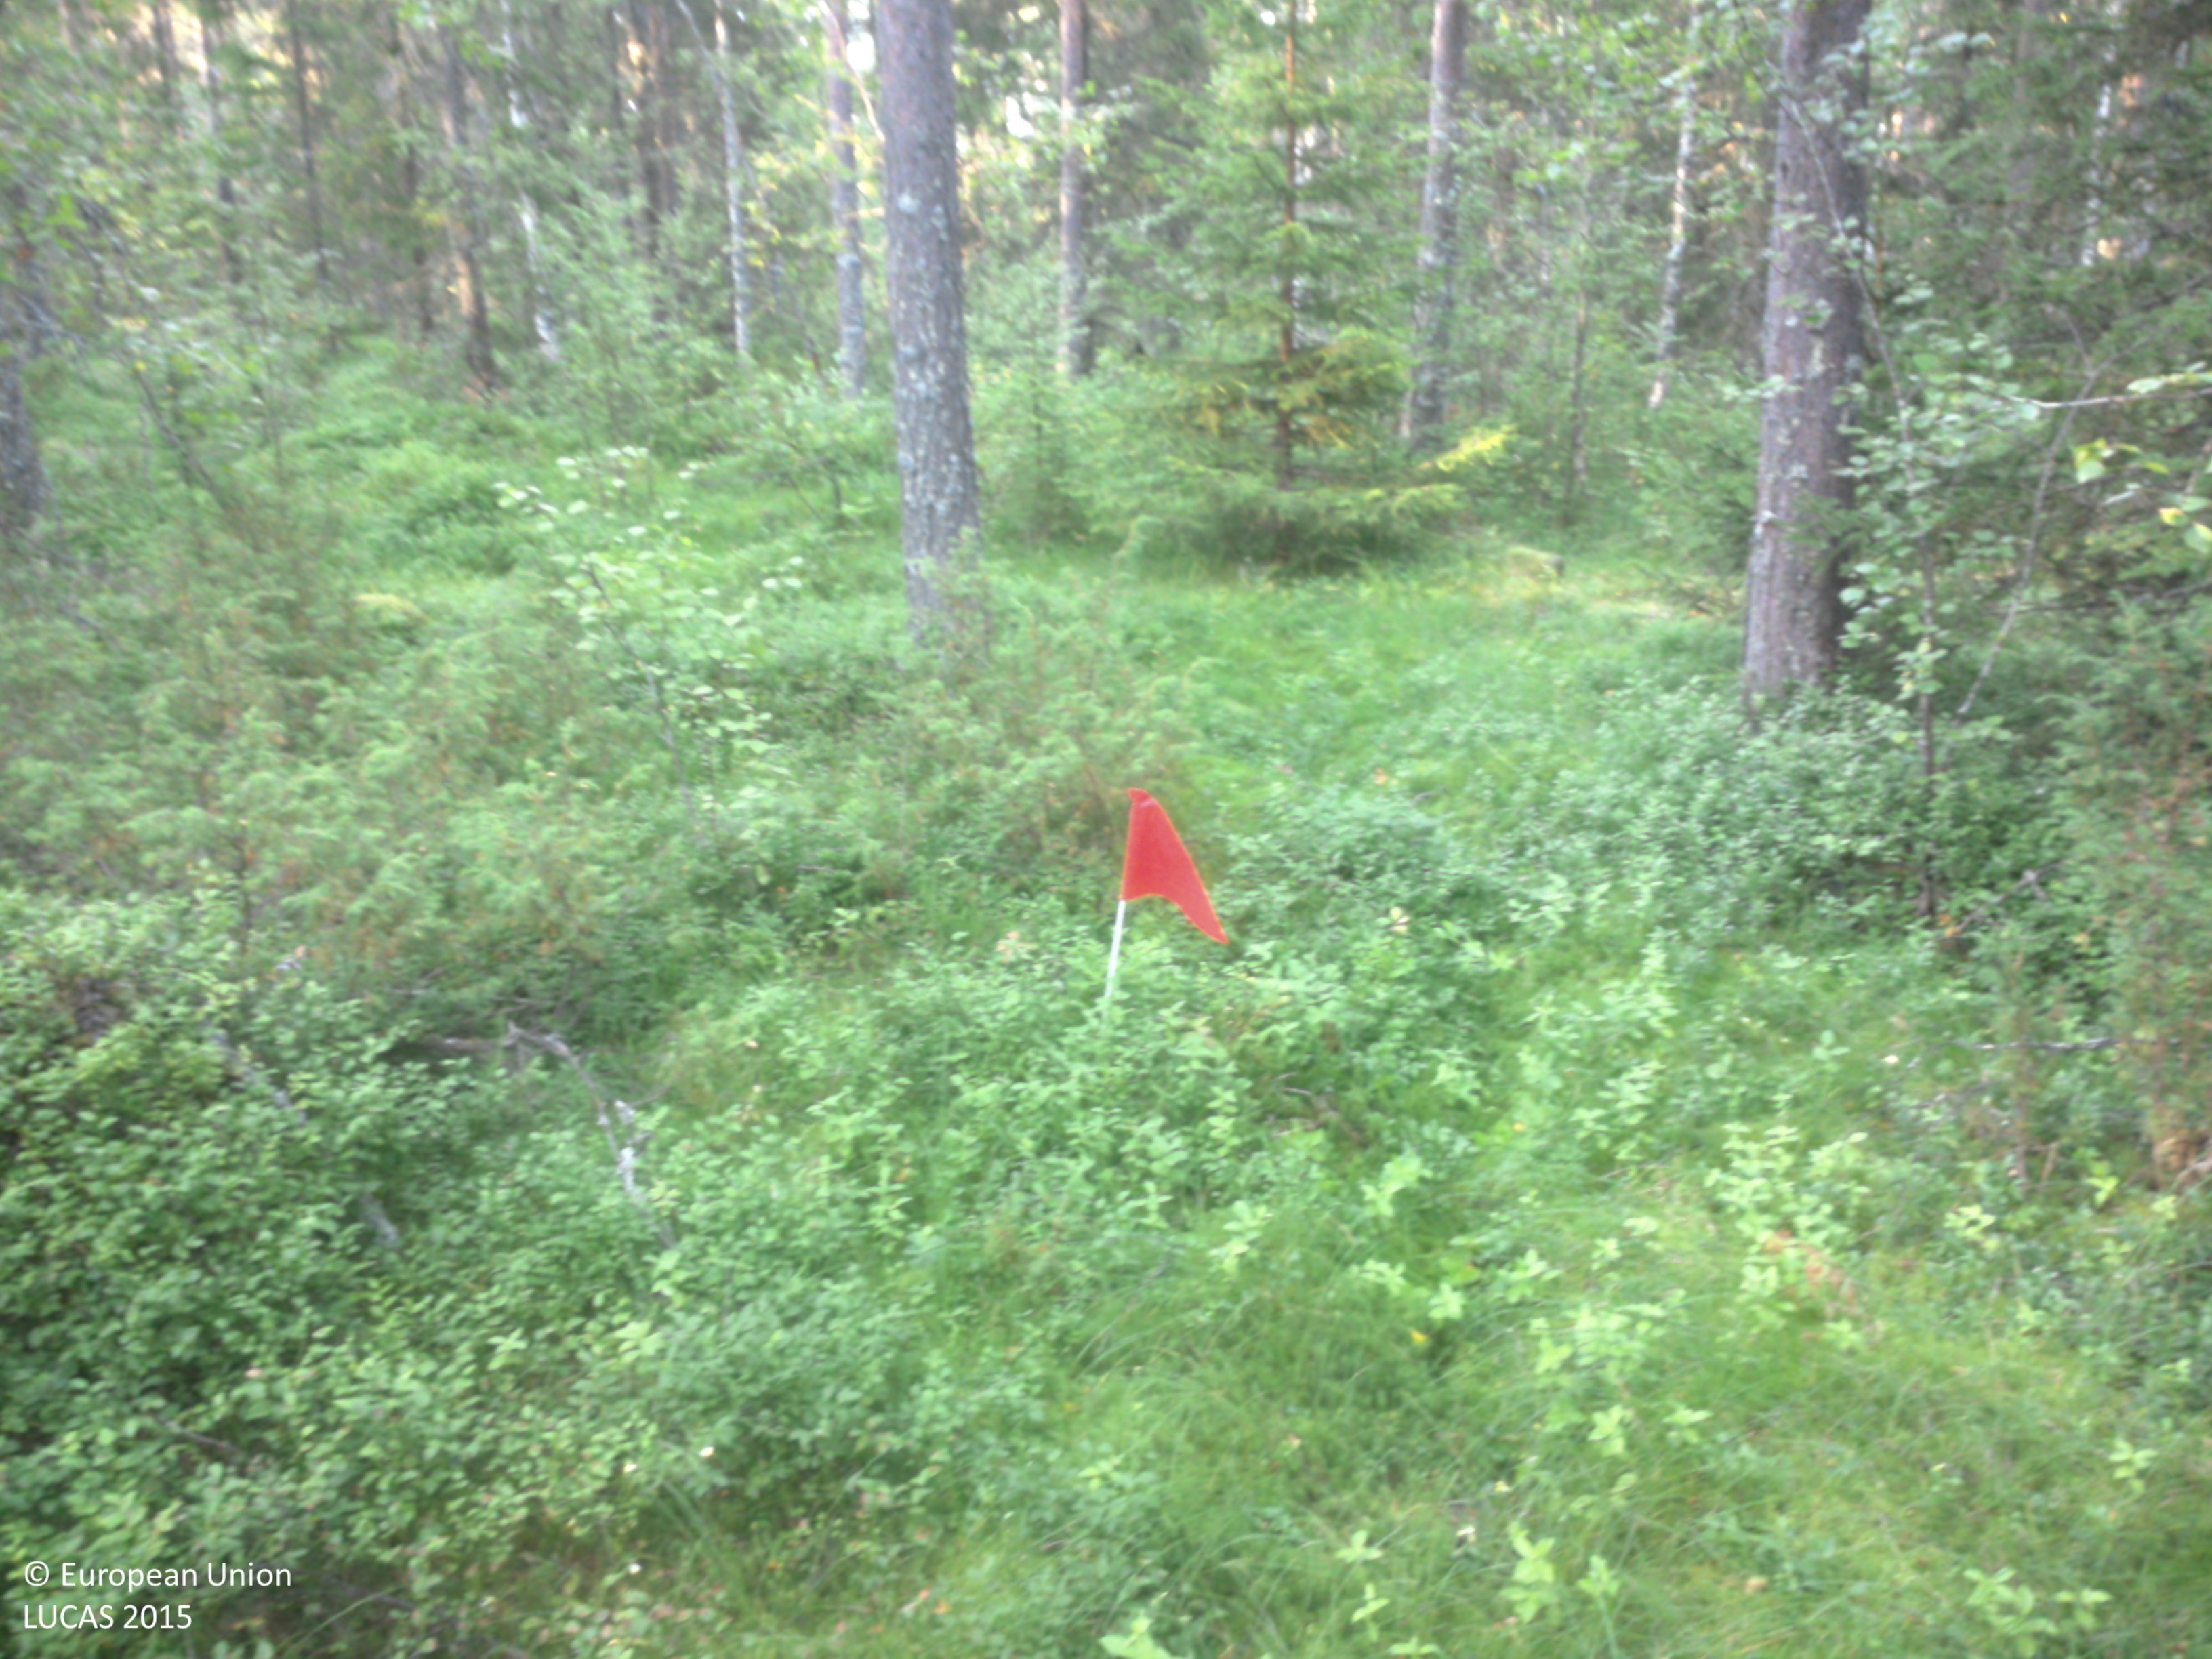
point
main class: Woodland
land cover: Other mixed woodland
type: boreal forest
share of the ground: 50 - 75 %
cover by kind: coniferous forest trees 40 %, herbaceous plants 30 %, broadleaved forest trees 20 %, shrubs 10 %
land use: Forestry
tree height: > 5 m
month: July
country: SE
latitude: 63.6868
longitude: 19.9088
